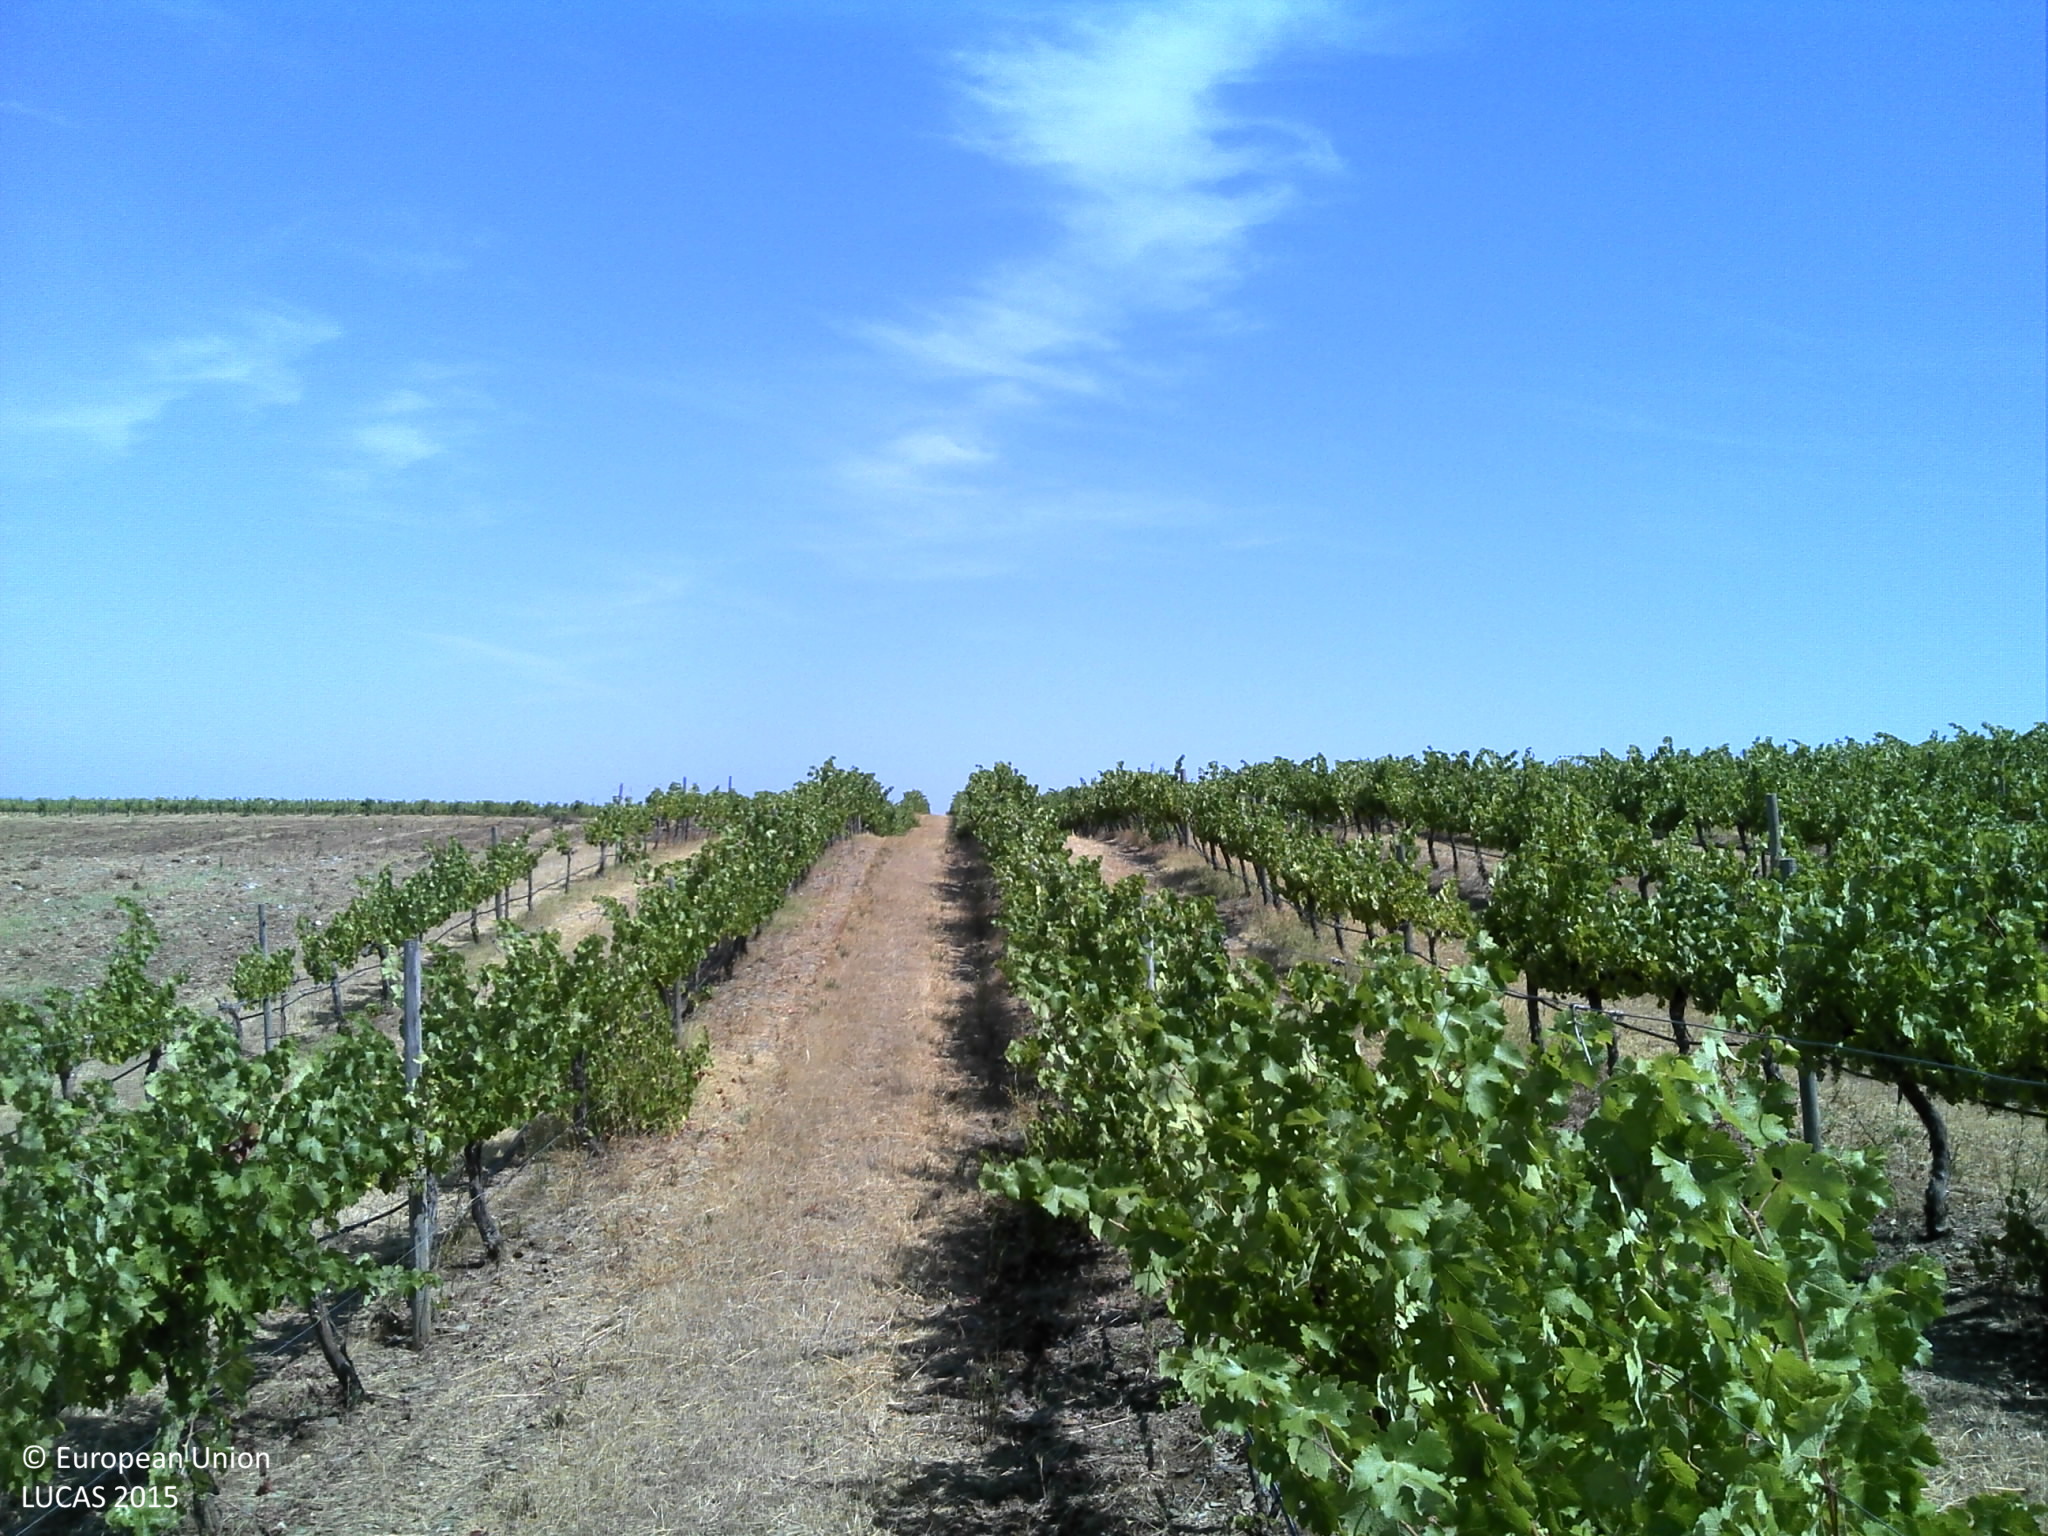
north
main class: Cropland
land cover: Vineyards
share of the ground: 25 - 50 %
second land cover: Grassland without tree/shrub cover
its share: 25 - 50 %
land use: Agriculture (excluding fallow land and kitchen gardens)
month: July
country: PT
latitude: 38.5037
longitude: -7.6570
